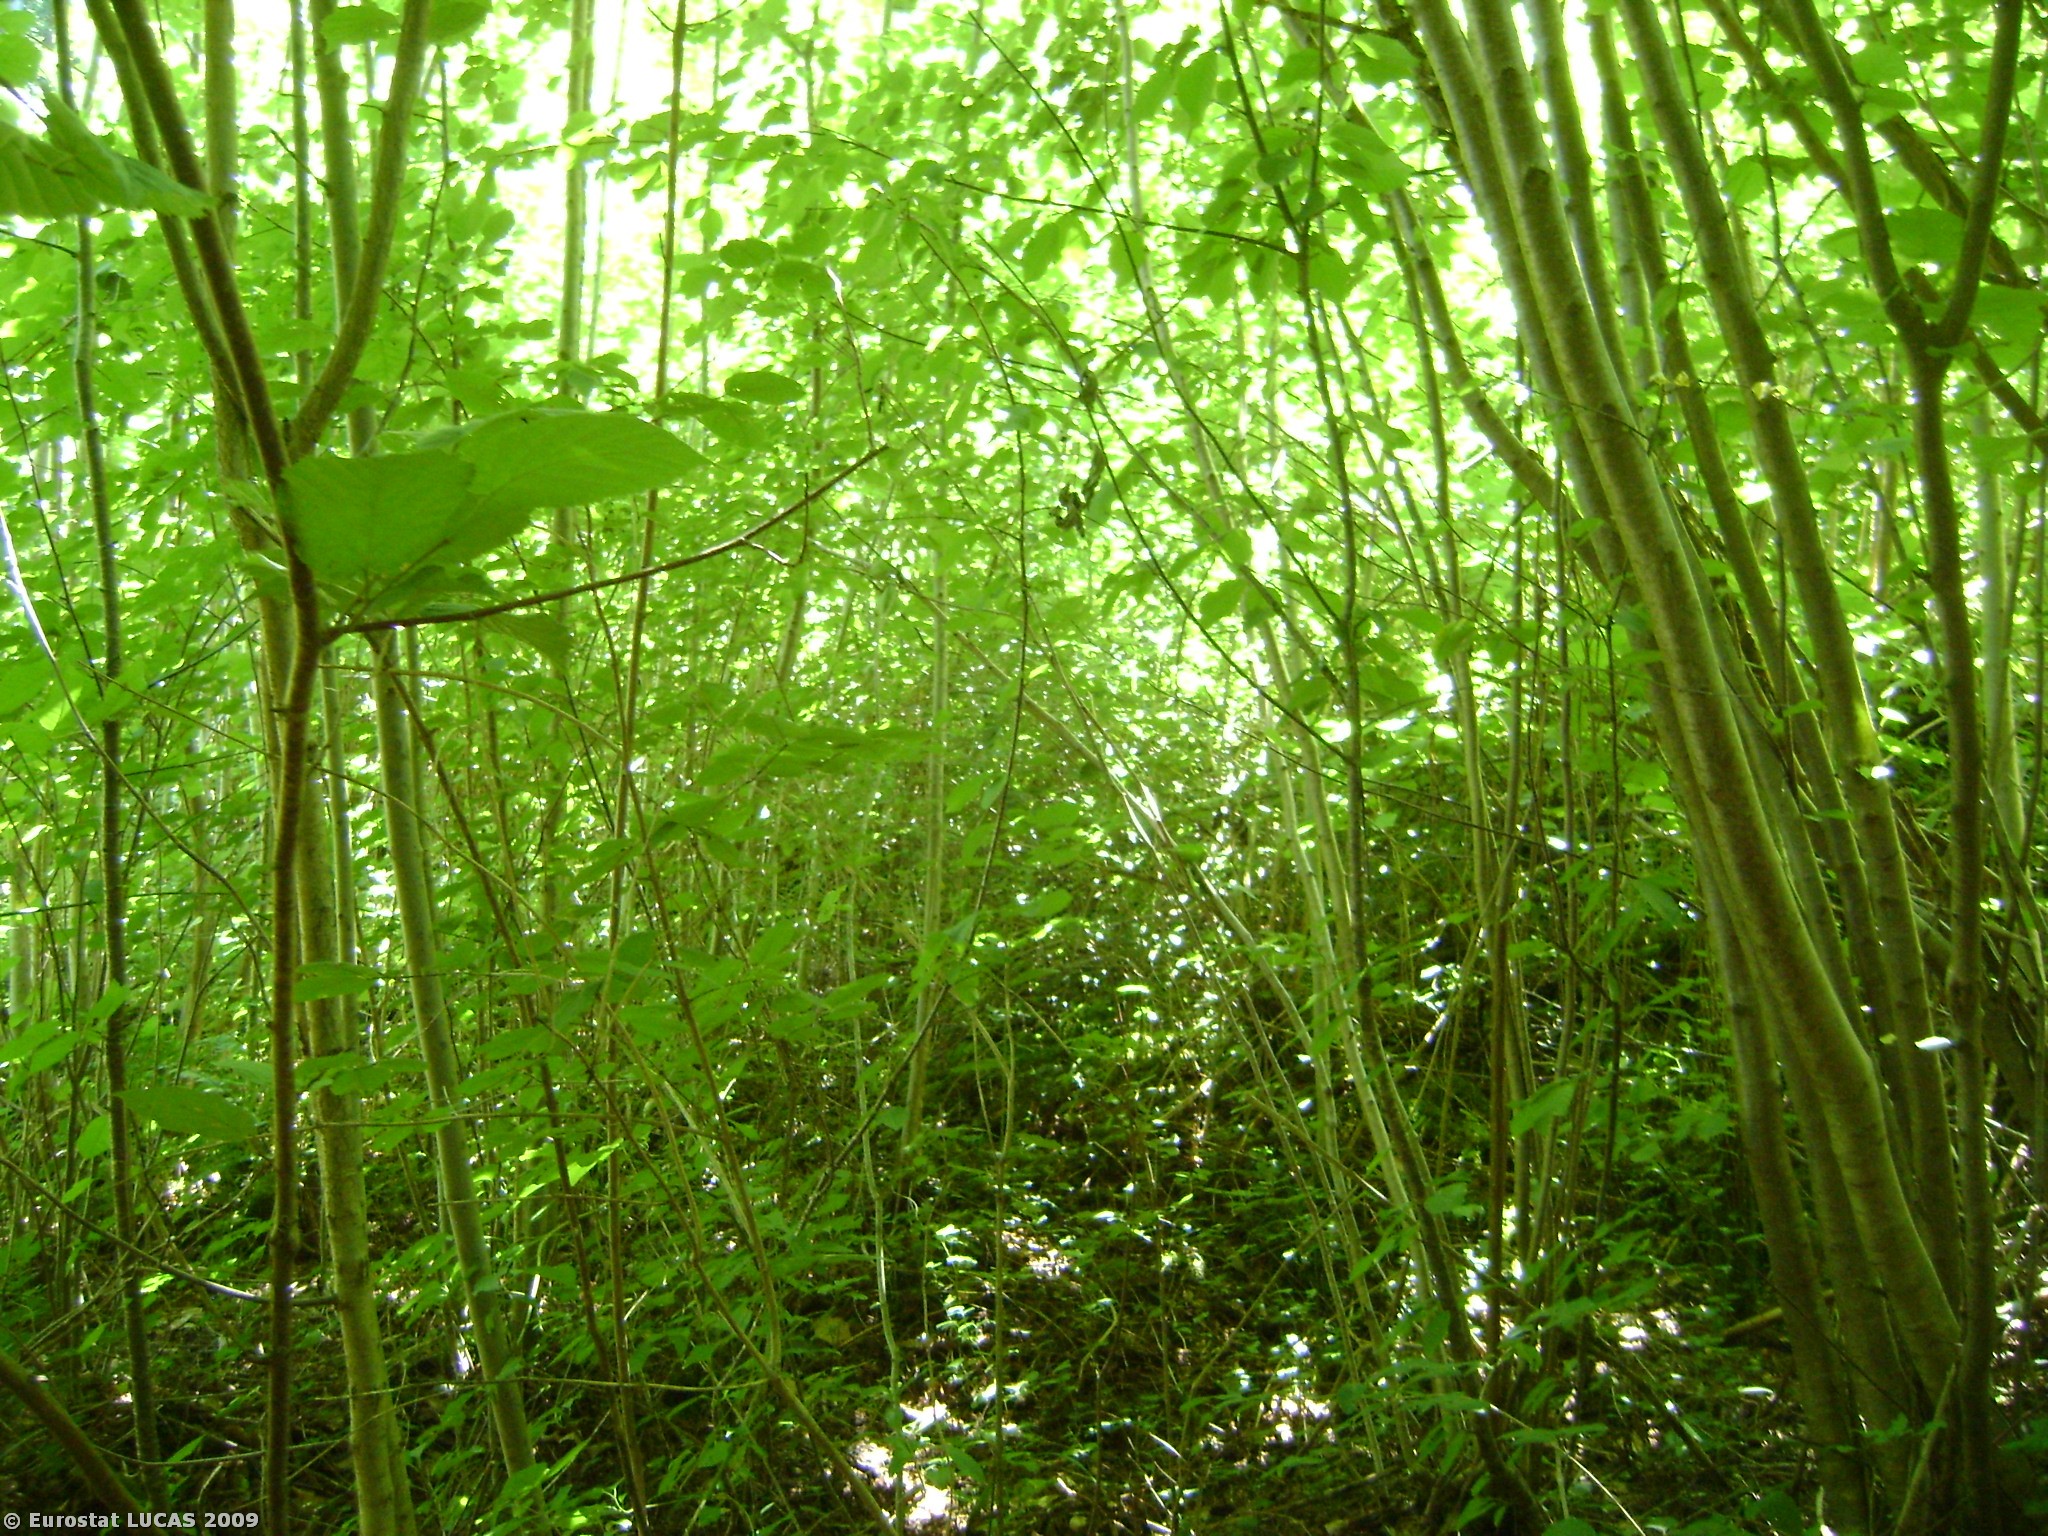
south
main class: Woodland
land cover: Broadleaved woodland
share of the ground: > 75 %
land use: Forestry
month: July
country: AT
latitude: 47.1971
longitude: 9.6703
